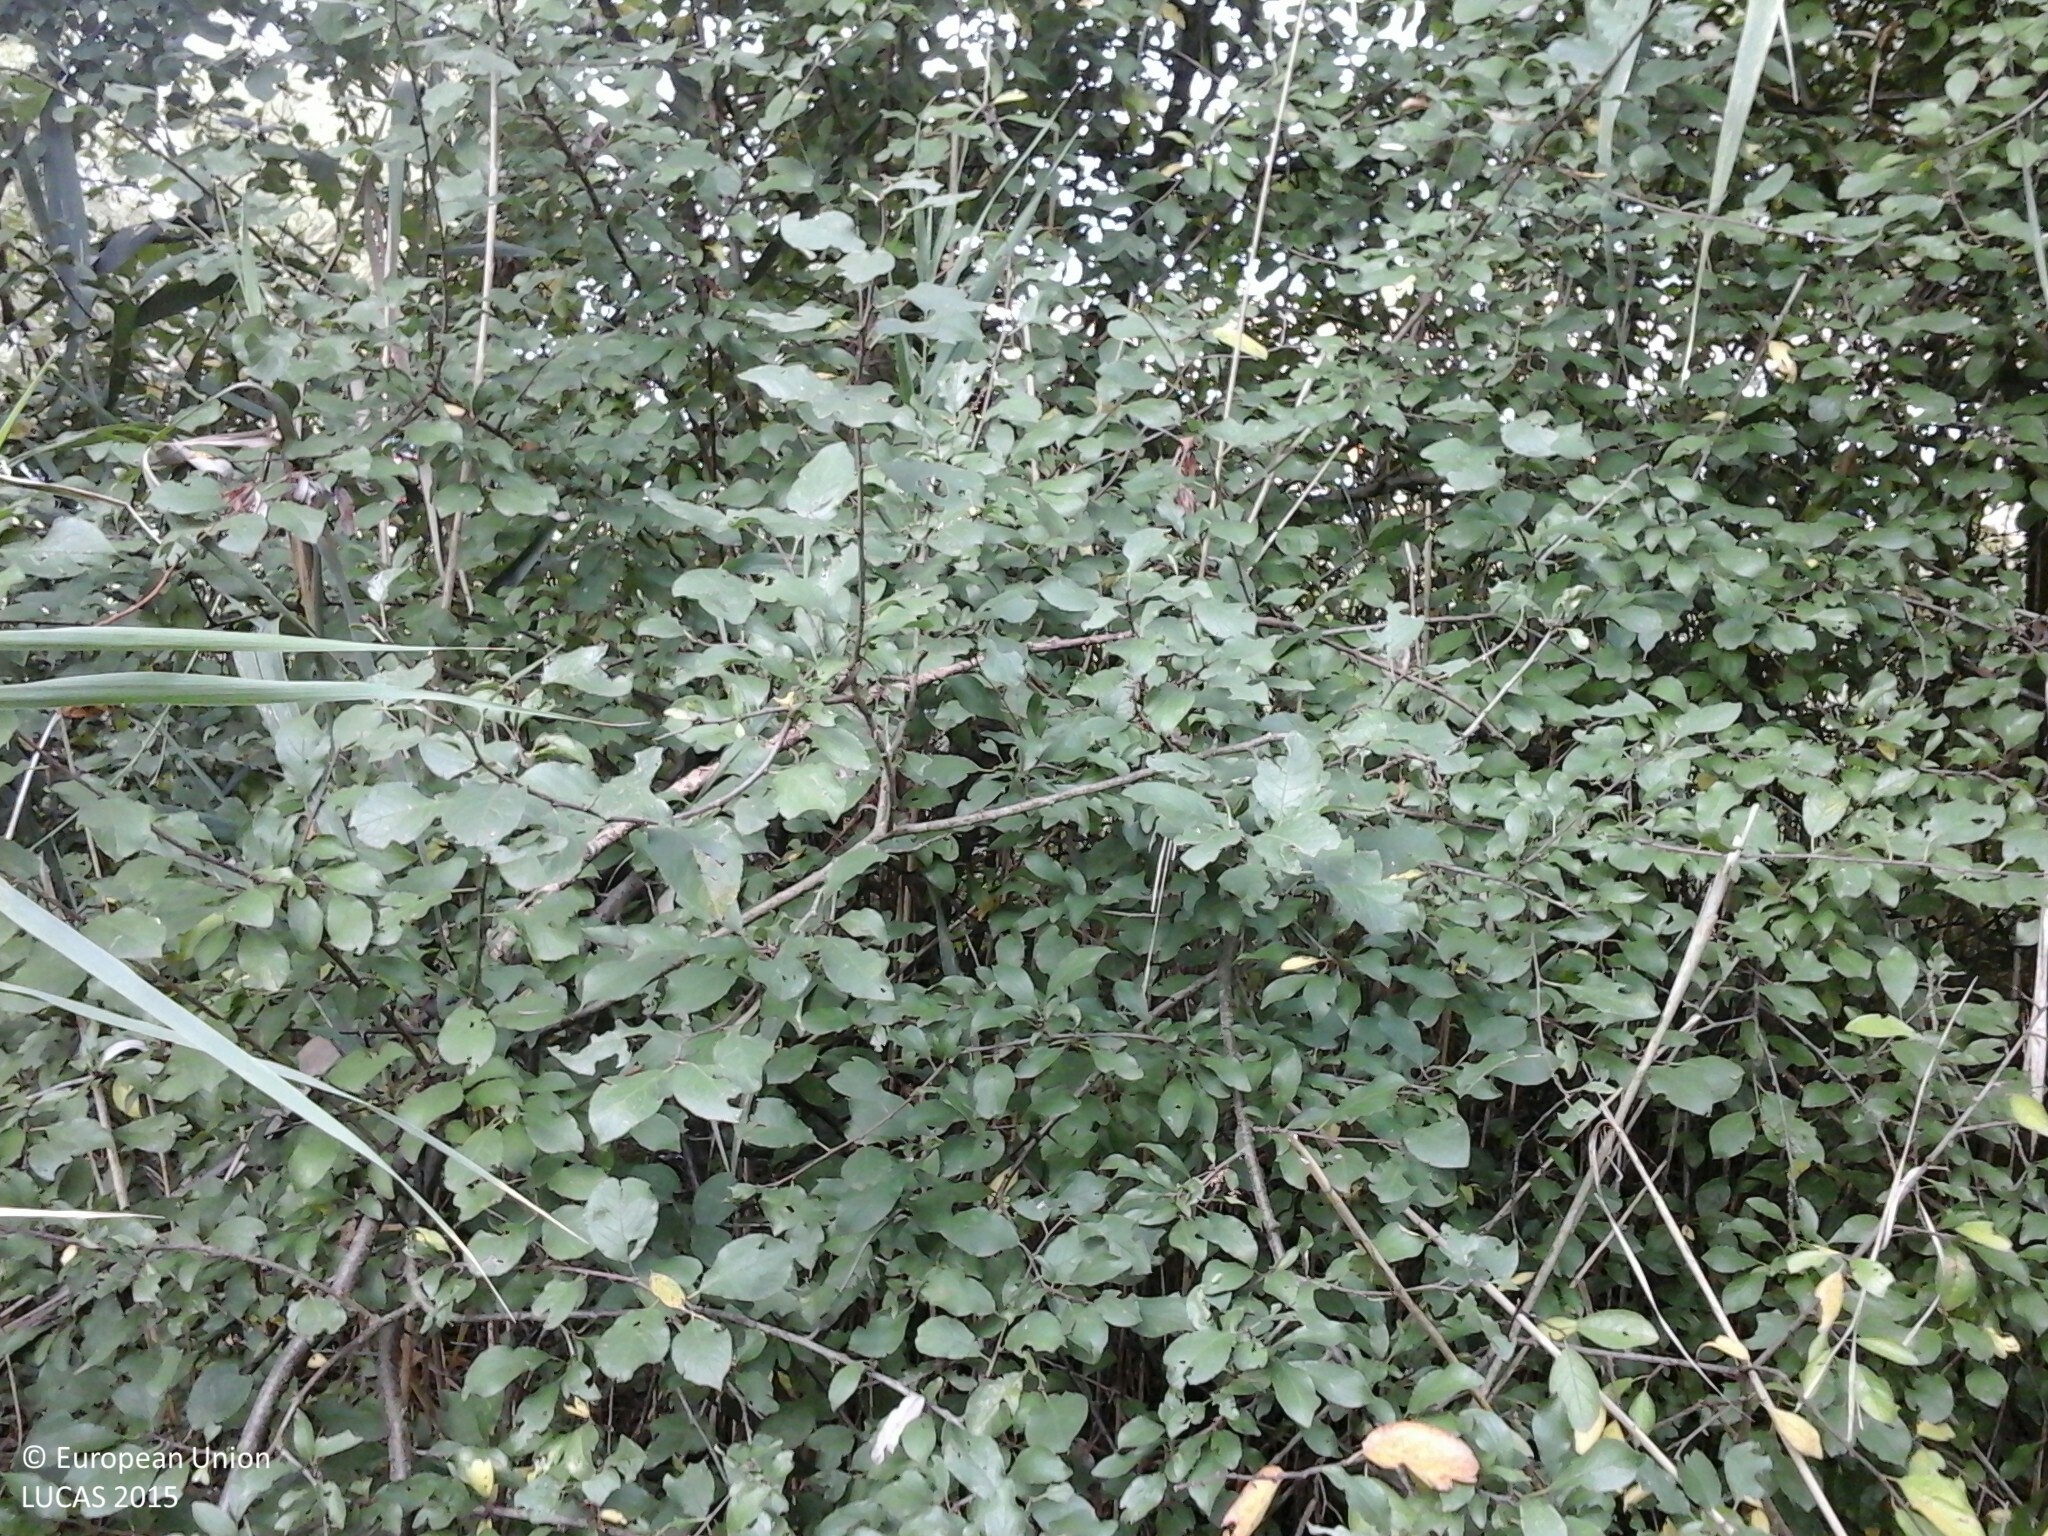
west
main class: Grassland
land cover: Grassland with sparse tree/shrub cover
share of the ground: > 75 %
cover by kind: herbaceous plants 85 %, shrubs 10 %, broadleaved forest trees 5 %
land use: Semi-natural and natural areas not in use
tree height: > 5 m
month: September
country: HU
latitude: 47.9835
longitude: 19.8203
